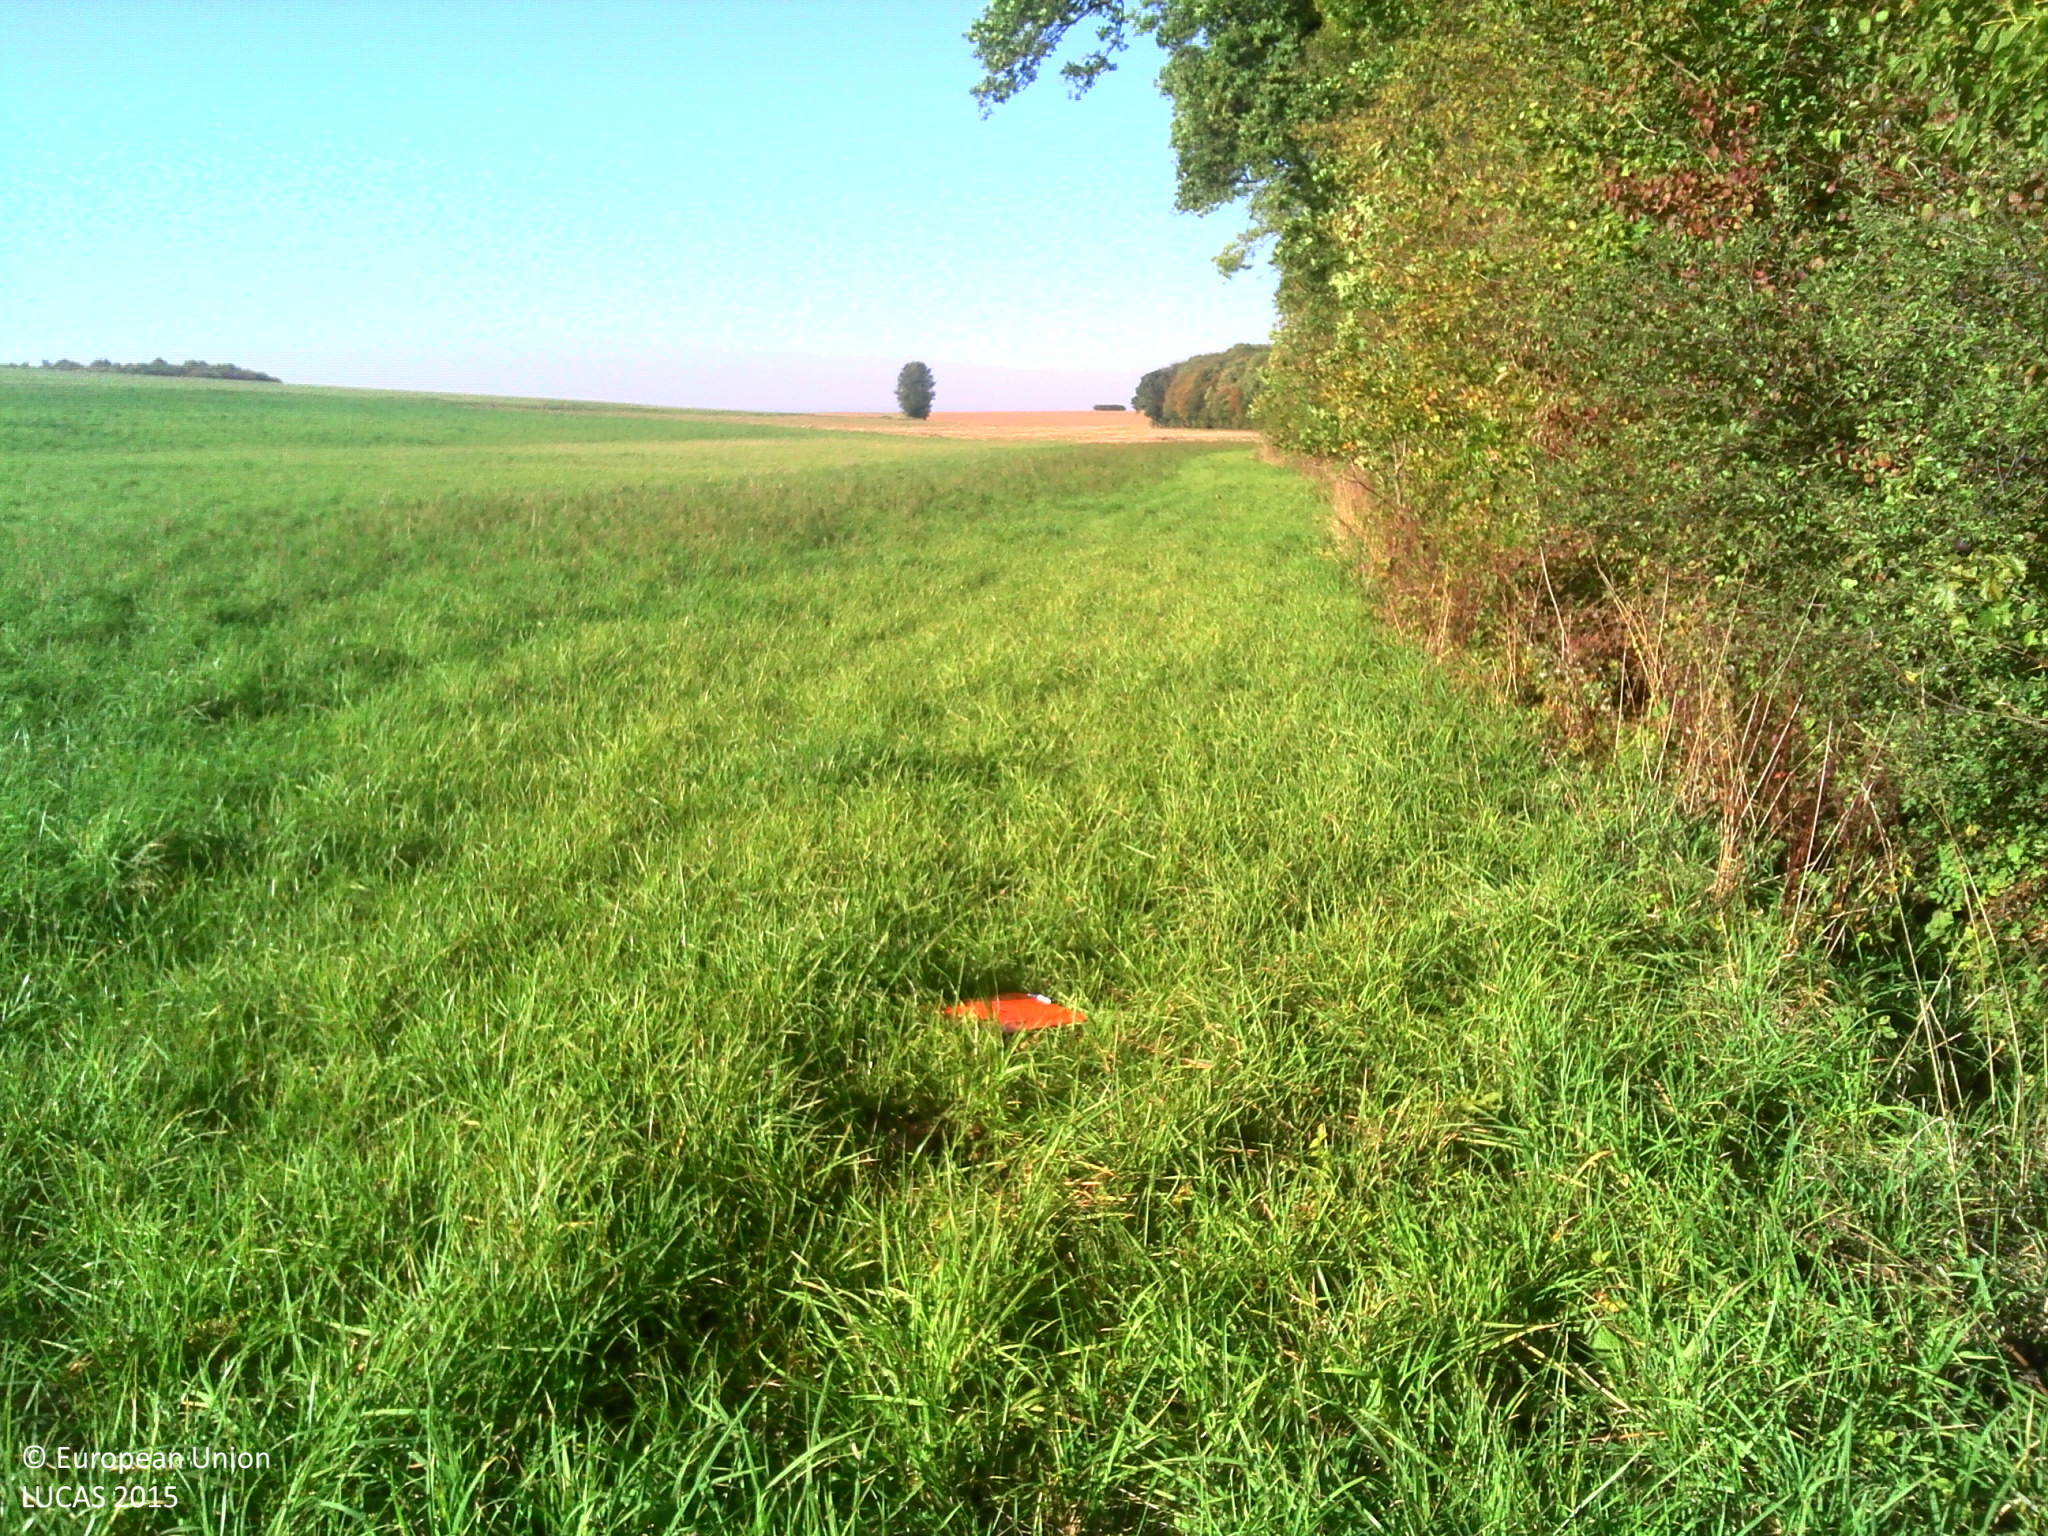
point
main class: Cropland
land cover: Temporary grasslands
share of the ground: > 75 %
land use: Agriculture (excluding fallow land and kitchen gardens)
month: October
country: FR
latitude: 49.1411
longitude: 5.9831
